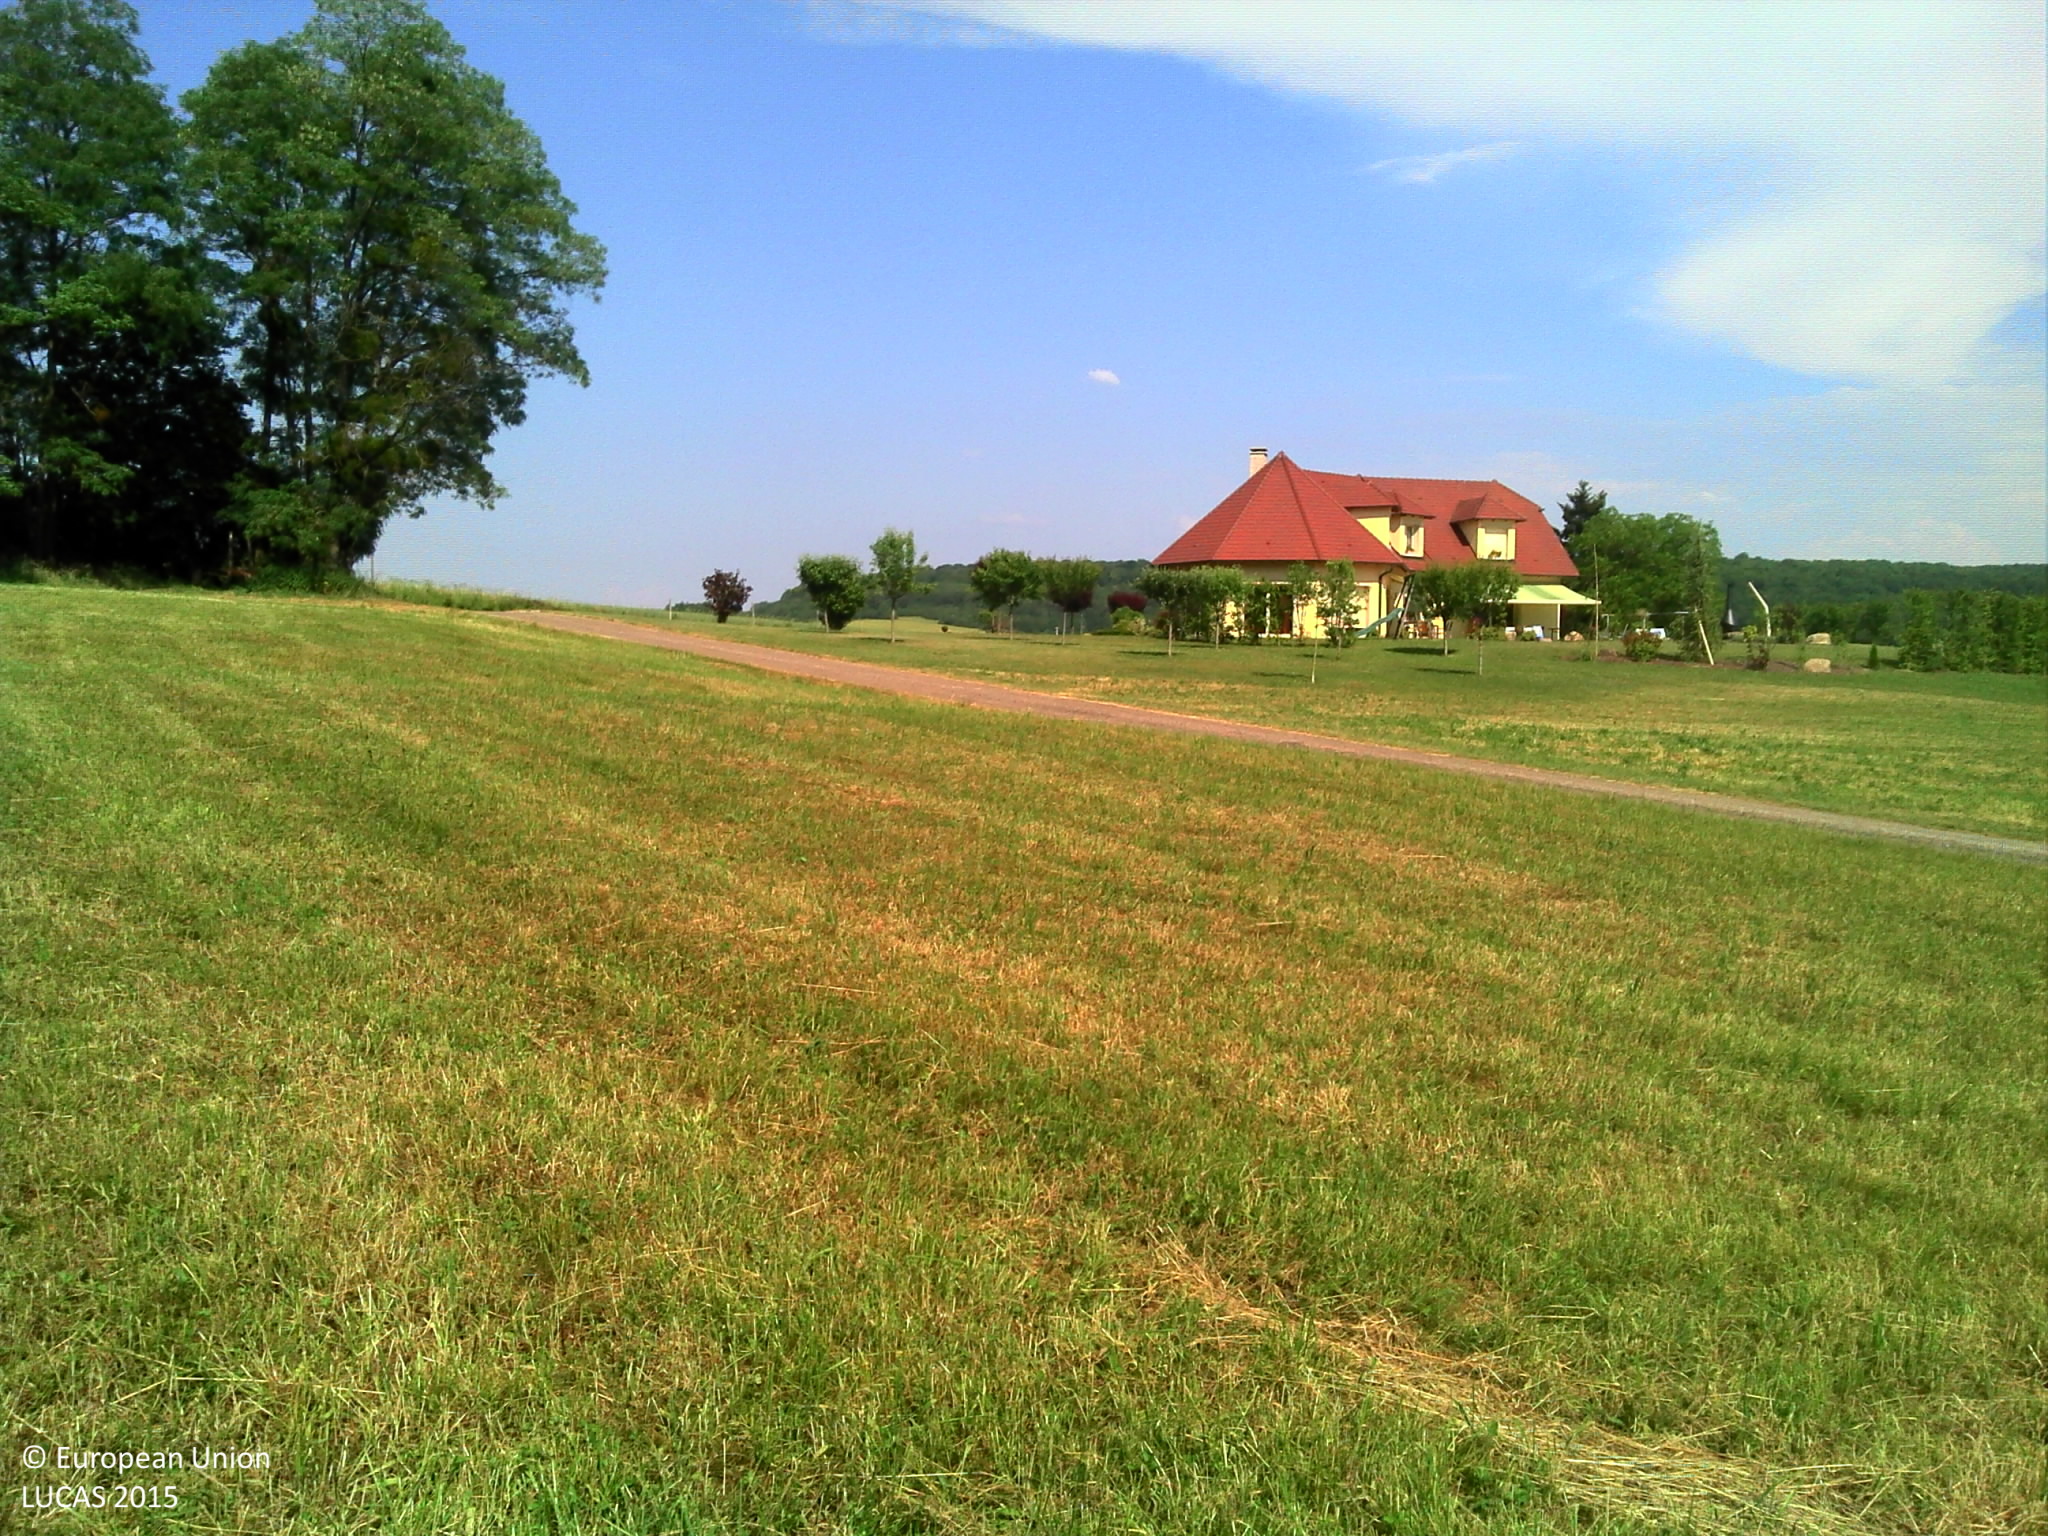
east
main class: Grassland
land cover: Grassland without tree/shrub cover
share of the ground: > 75 %
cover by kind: herbaceous plants 100 %
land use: Agriculture (excluding fallow land and kitchen gardens)
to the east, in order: Grassland without tree/shrub cover; Grass margins; Paved roads, cycling and walking lanes; Grass margins; Grassland with sparse tree/shrub cover; Artificial constructions in urban areas; Common wheat
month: June
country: FR
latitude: 47.6036
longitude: 6.3169
